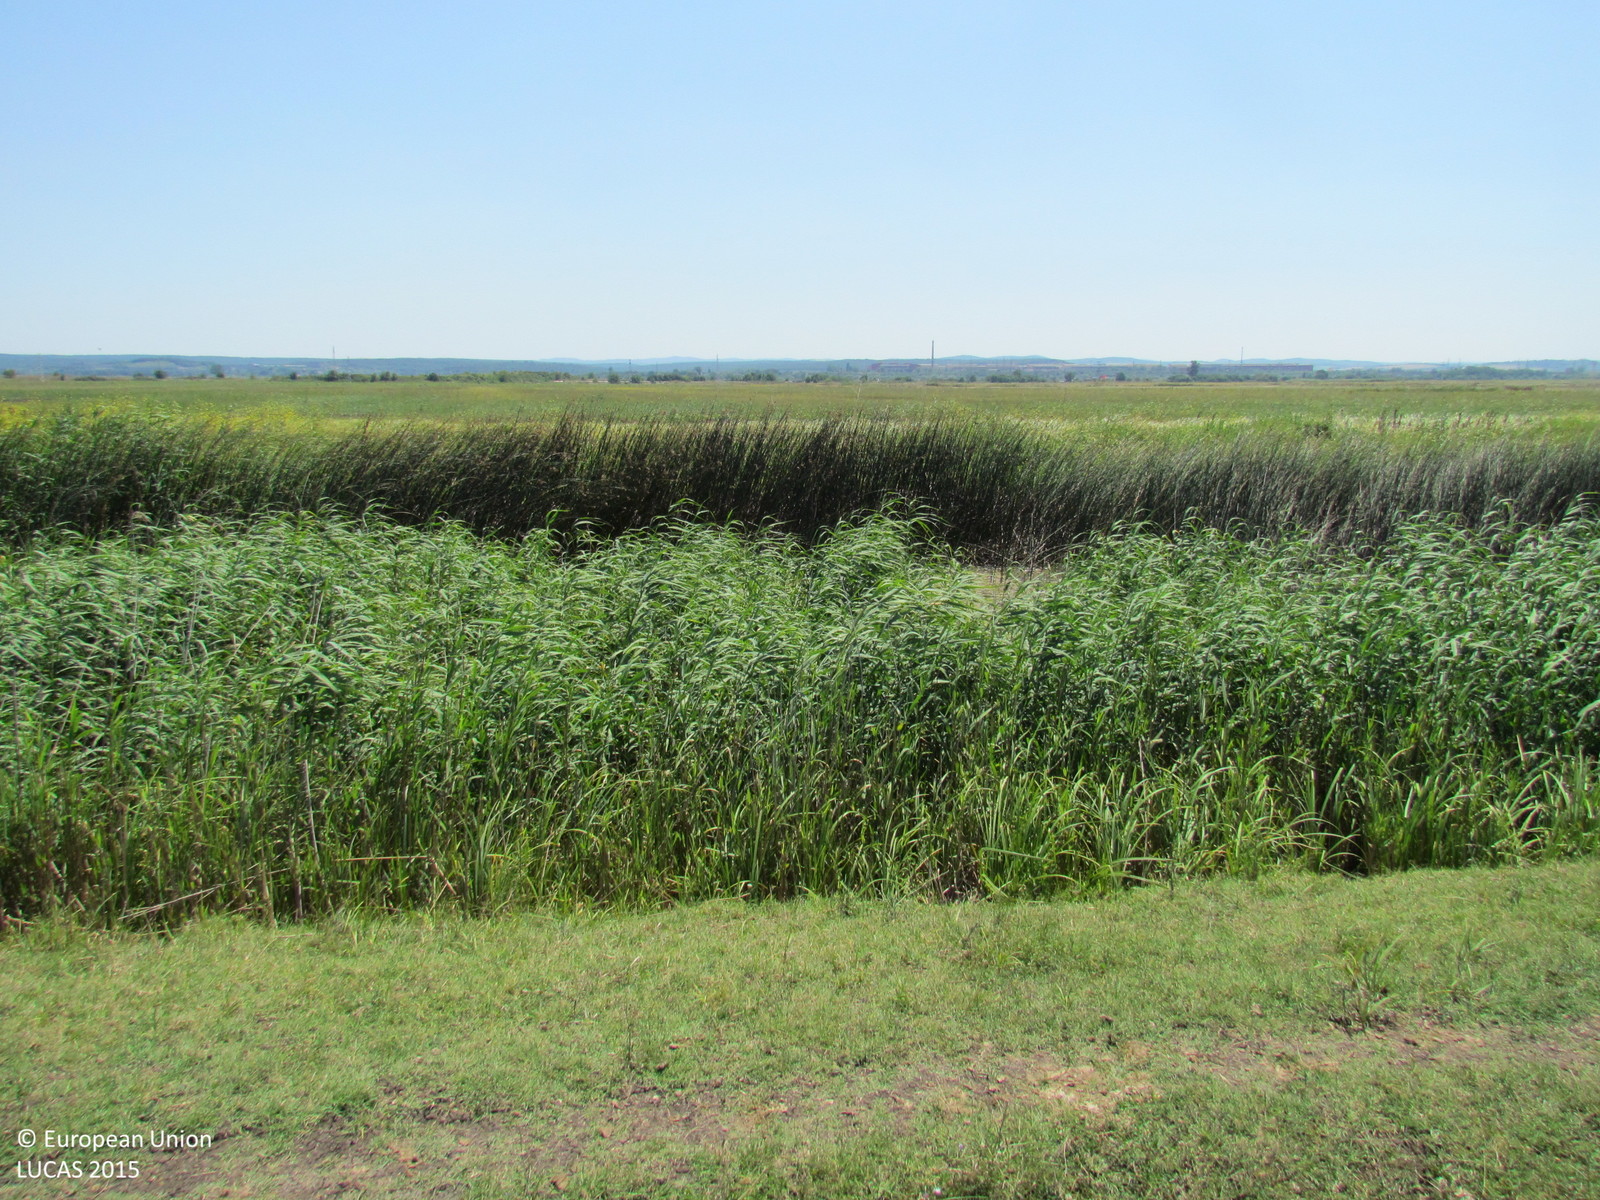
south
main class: Grassland
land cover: Spontaneously vegetated surfaces
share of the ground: > 75 %
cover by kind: herbaceous plants 100 %
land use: Fallow land
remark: Temporary flooded
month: July
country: BG
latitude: 42.4044
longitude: 27.3035
